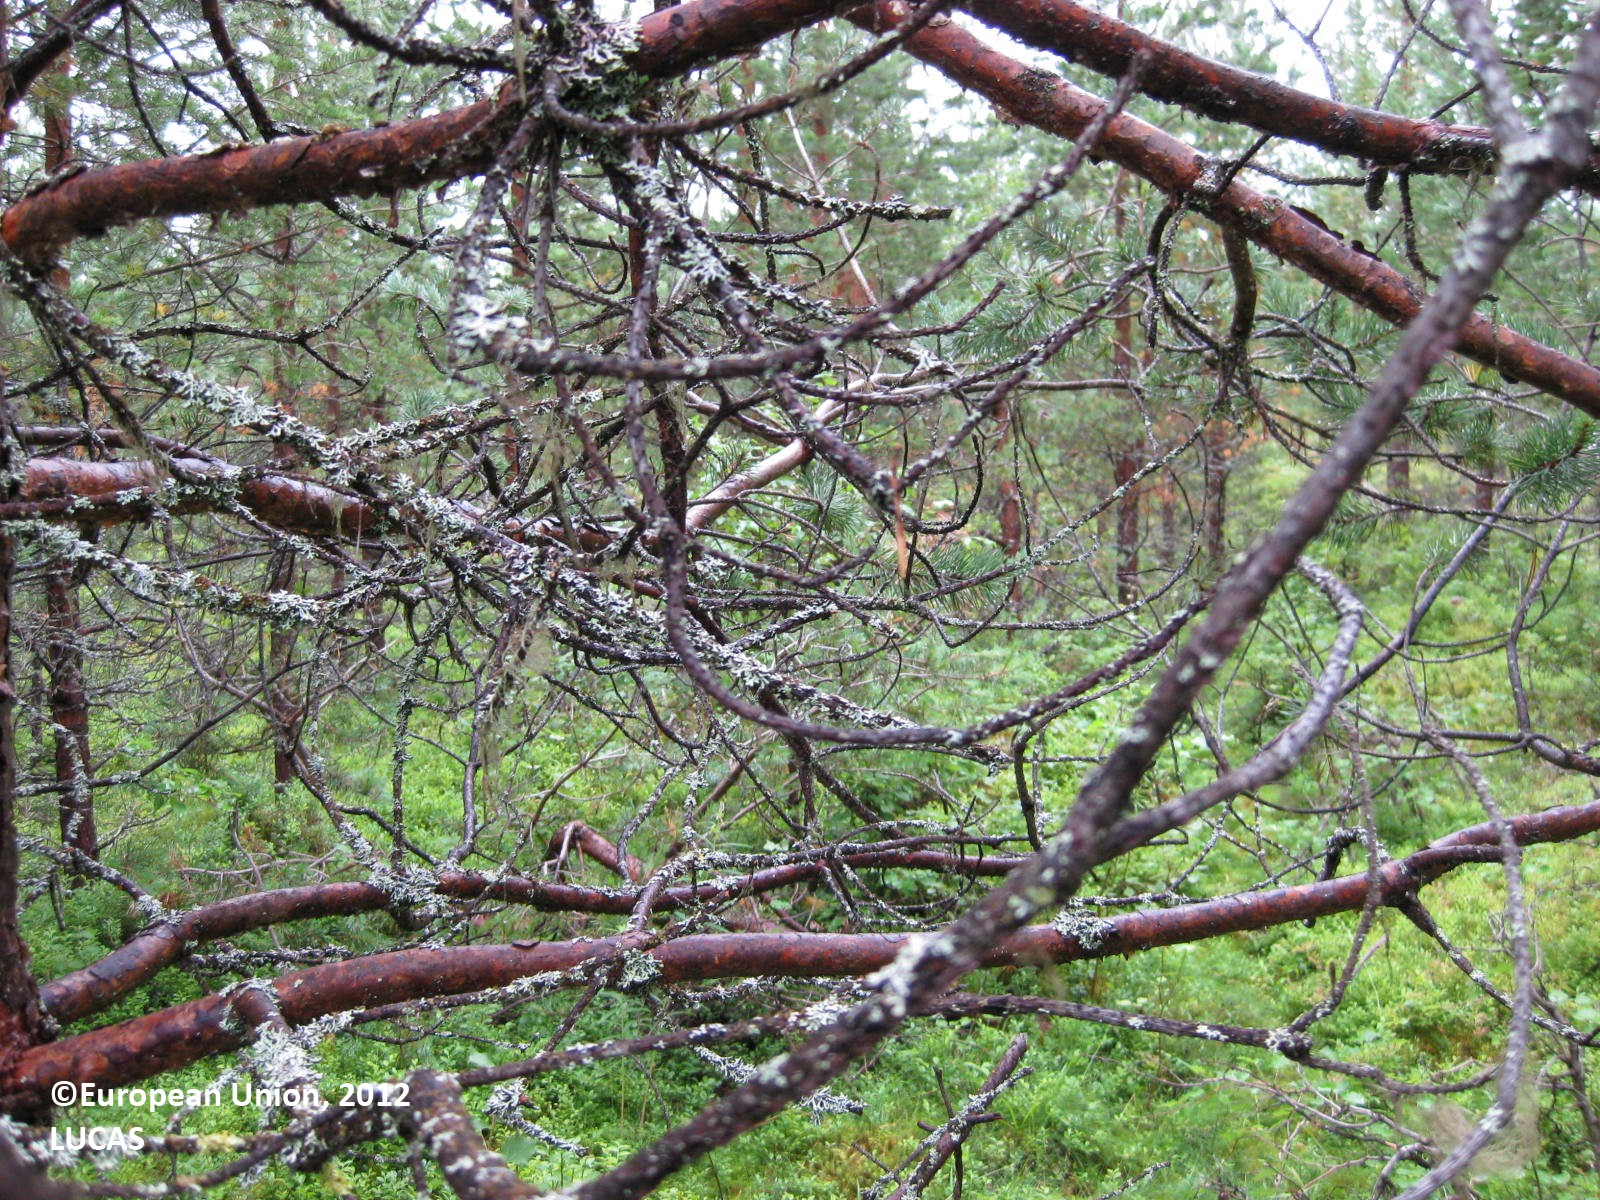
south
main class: Woodland
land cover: Pine dominated coniferous woodland
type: boreal forest
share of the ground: > 75 %
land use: Forestry
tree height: > 5 m
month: August
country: FI
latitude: 65.8719
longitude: 28.1884
